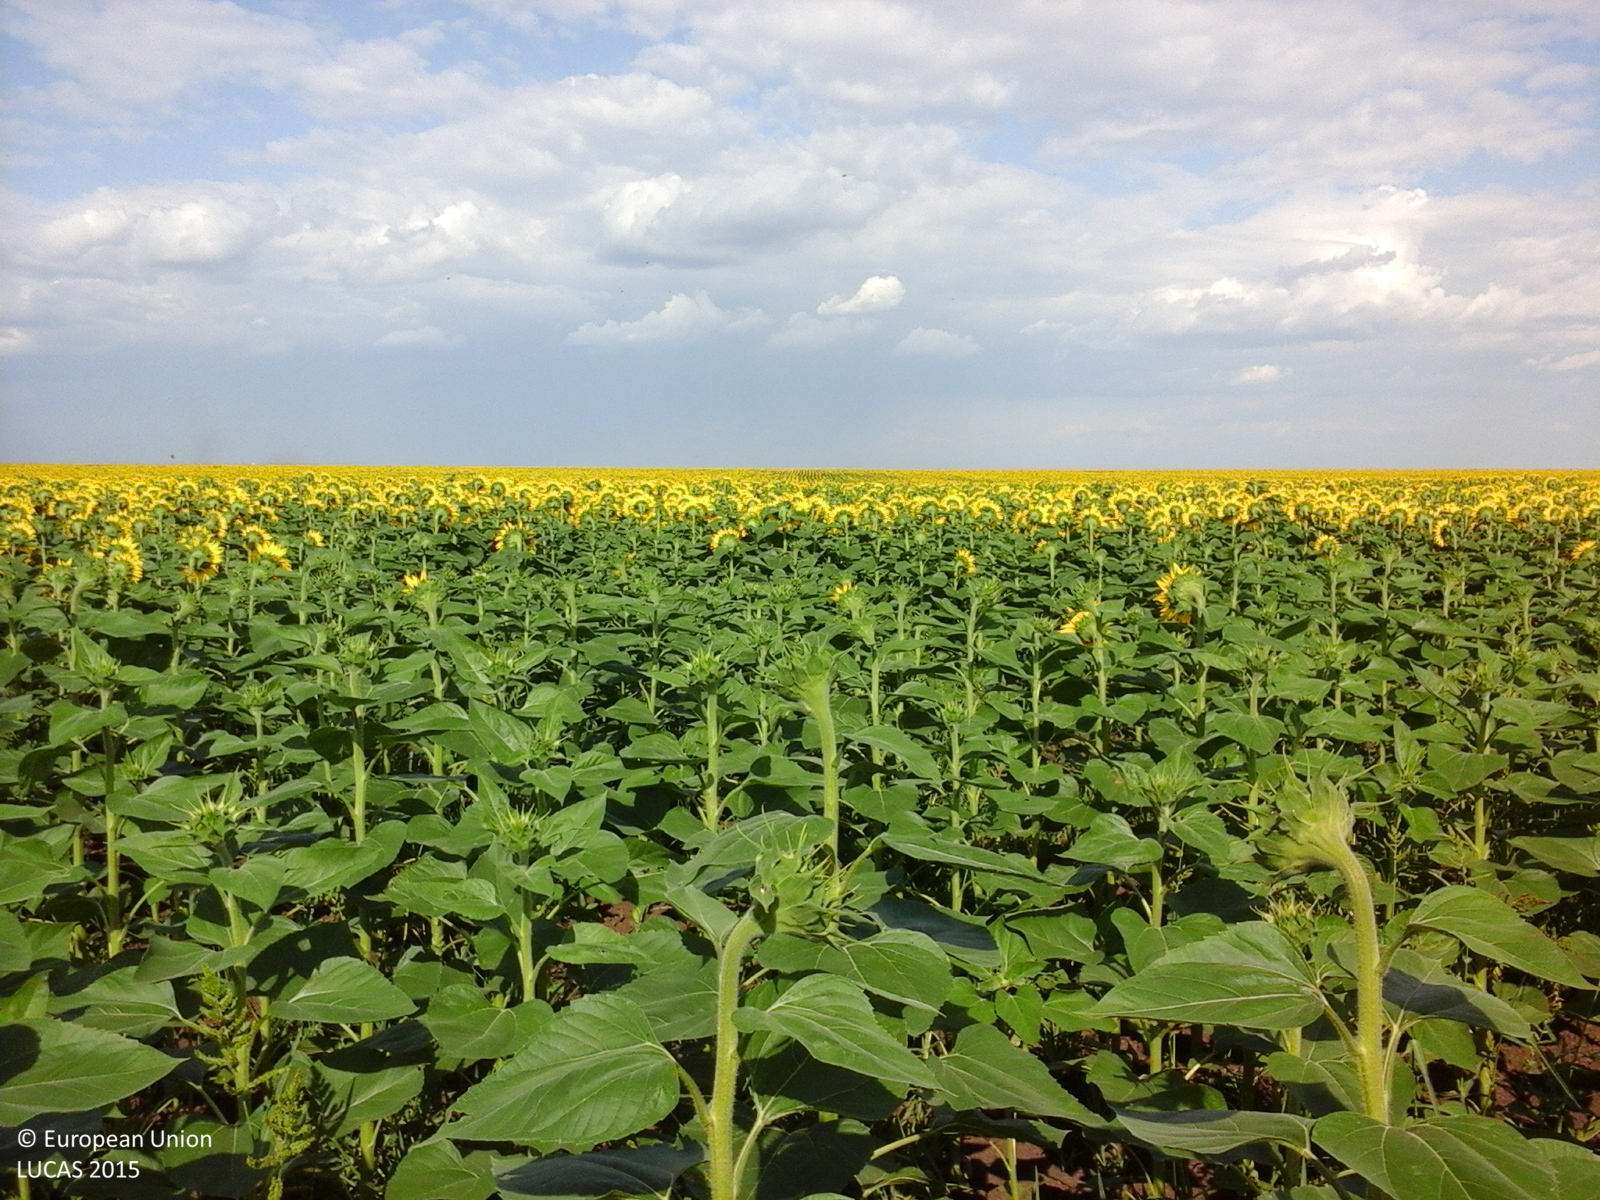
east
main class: Cropland
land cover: Sunflower
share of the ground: > 75 %
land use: Agriculture (excluding fallow land and kitchen gardens)
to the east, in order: Sunflower
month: July
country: RO
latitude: 44.0777
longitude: 24.8717
